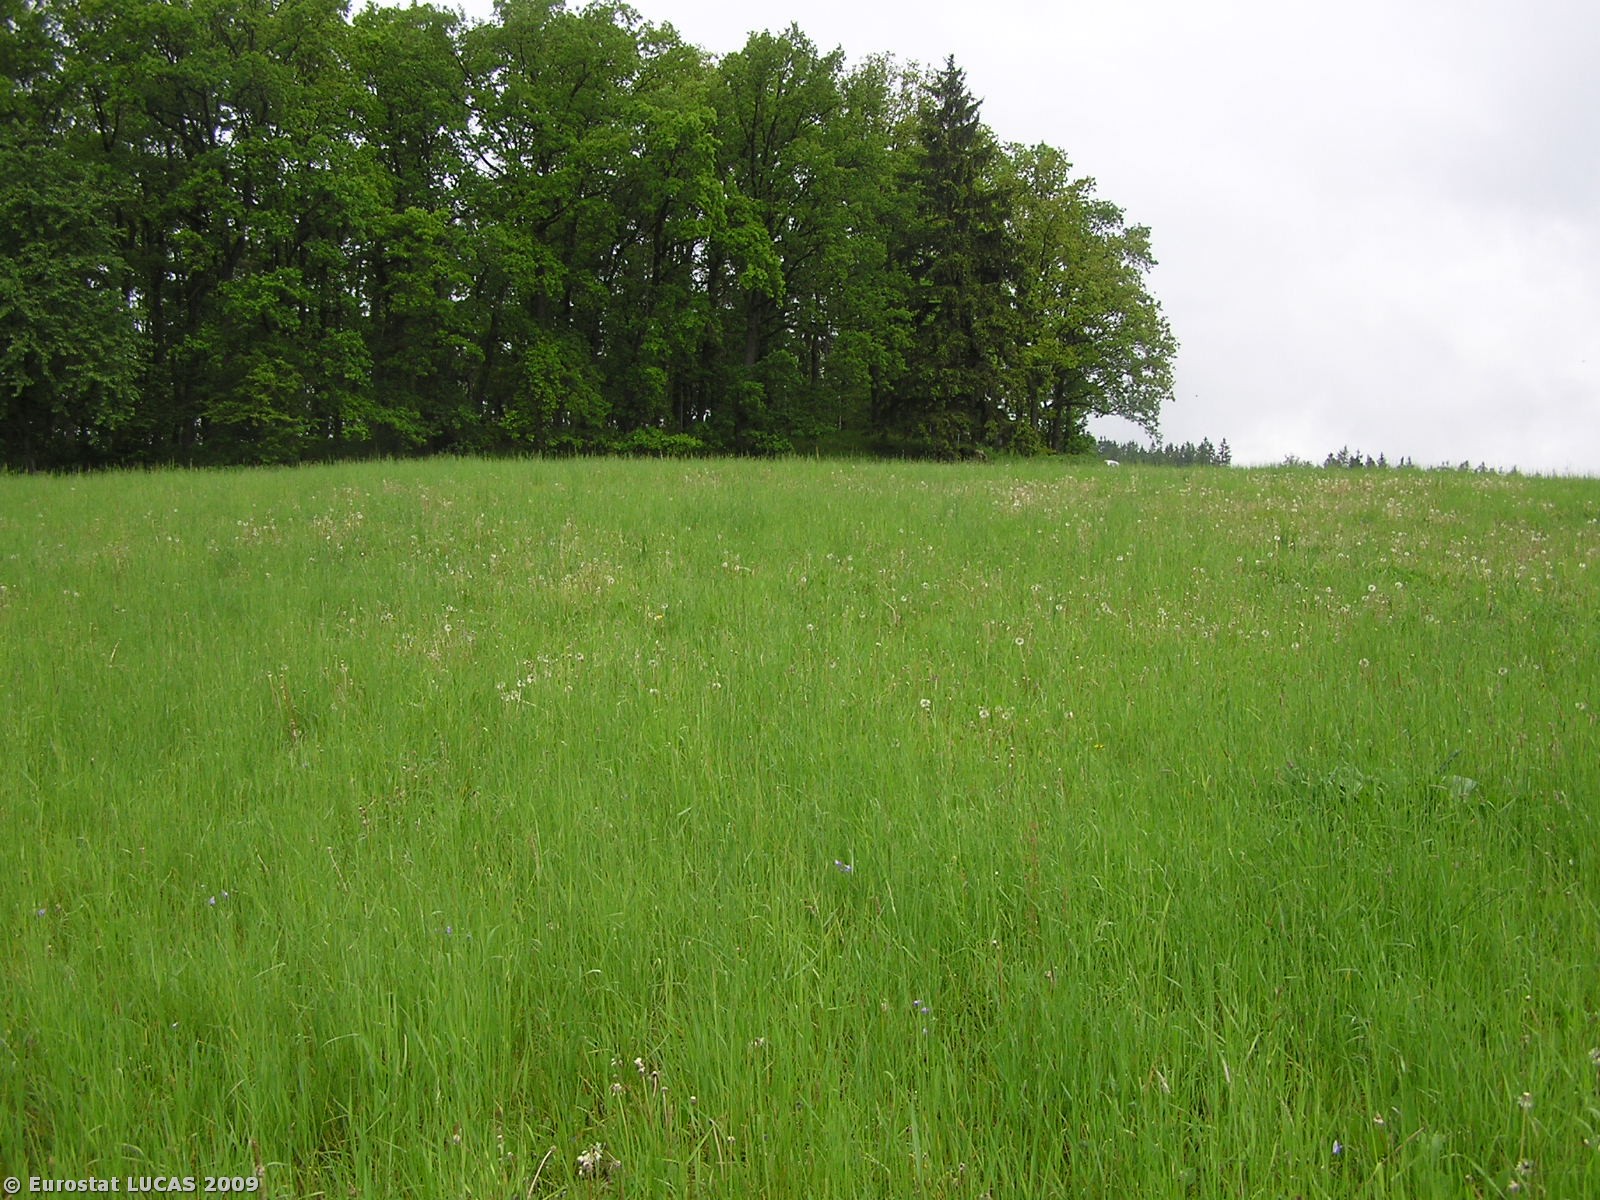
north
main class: Grassland
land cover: Grassland without tree/shrub cover
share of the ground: > 75 %
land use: Agriculture (excluding fallow land and kitchen gardens)
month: May
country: CZ
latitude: 49.4791
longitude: 14.5977
